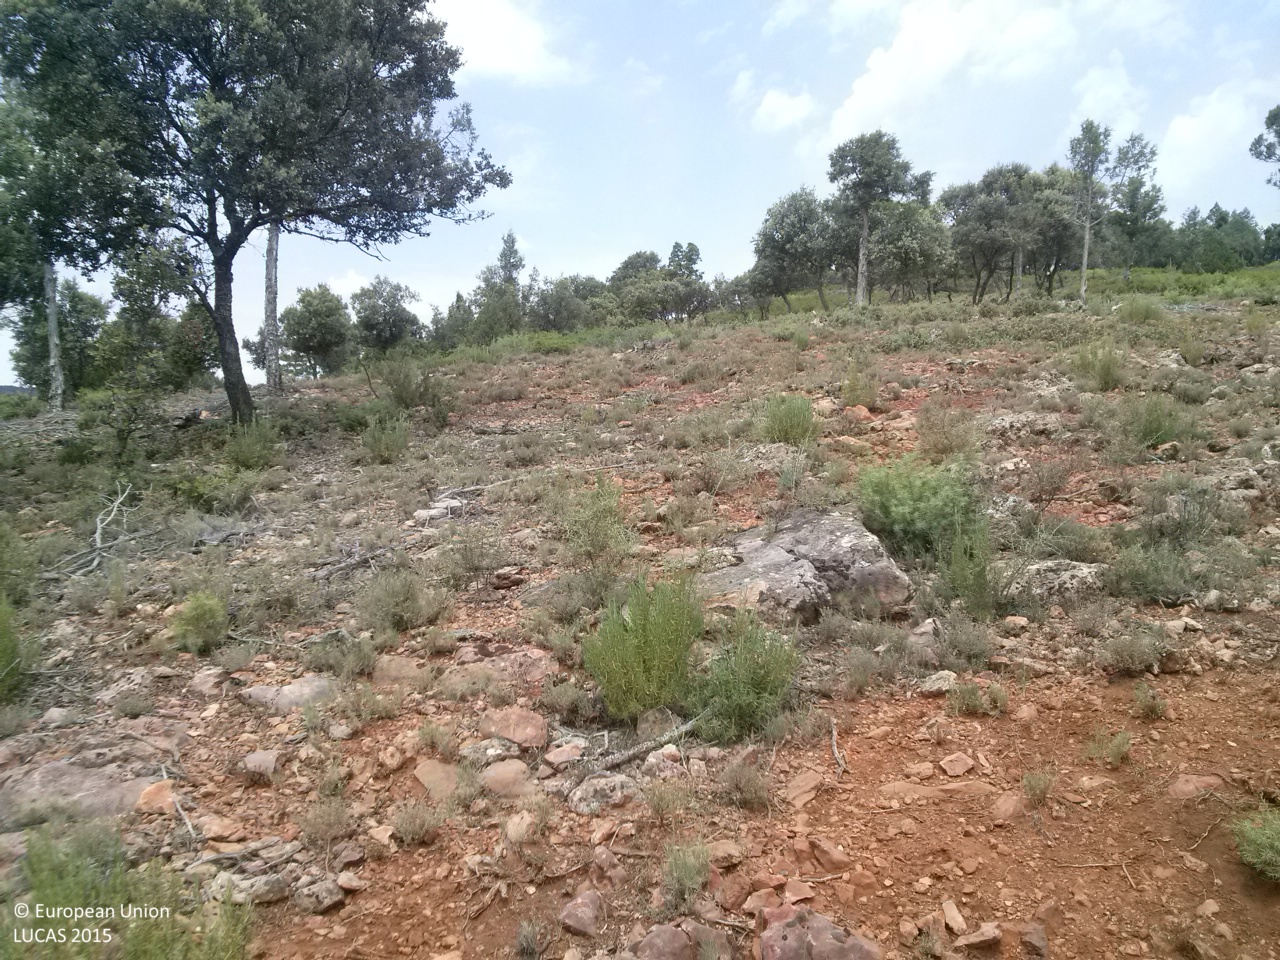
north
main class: Woodland
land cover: Other mixed woodland
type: broadleaved evergreen forest
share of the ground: 25 - 50 %
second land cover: Grassland without tree/shrub cover
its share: 25 - 50 %
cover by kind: herbaceous plants 30 %, broadleaved forest trees 20 %, shrubs 20 %, unconsolidated bare surface 20 %, coniferous forest trees 10 %
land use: Forestry
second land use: Agriculture (excluding fallow land and kitchen gardens)
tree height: < 5 m
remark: Clear cut
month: June
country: ES
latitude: 39.9931
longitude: -1.7825
